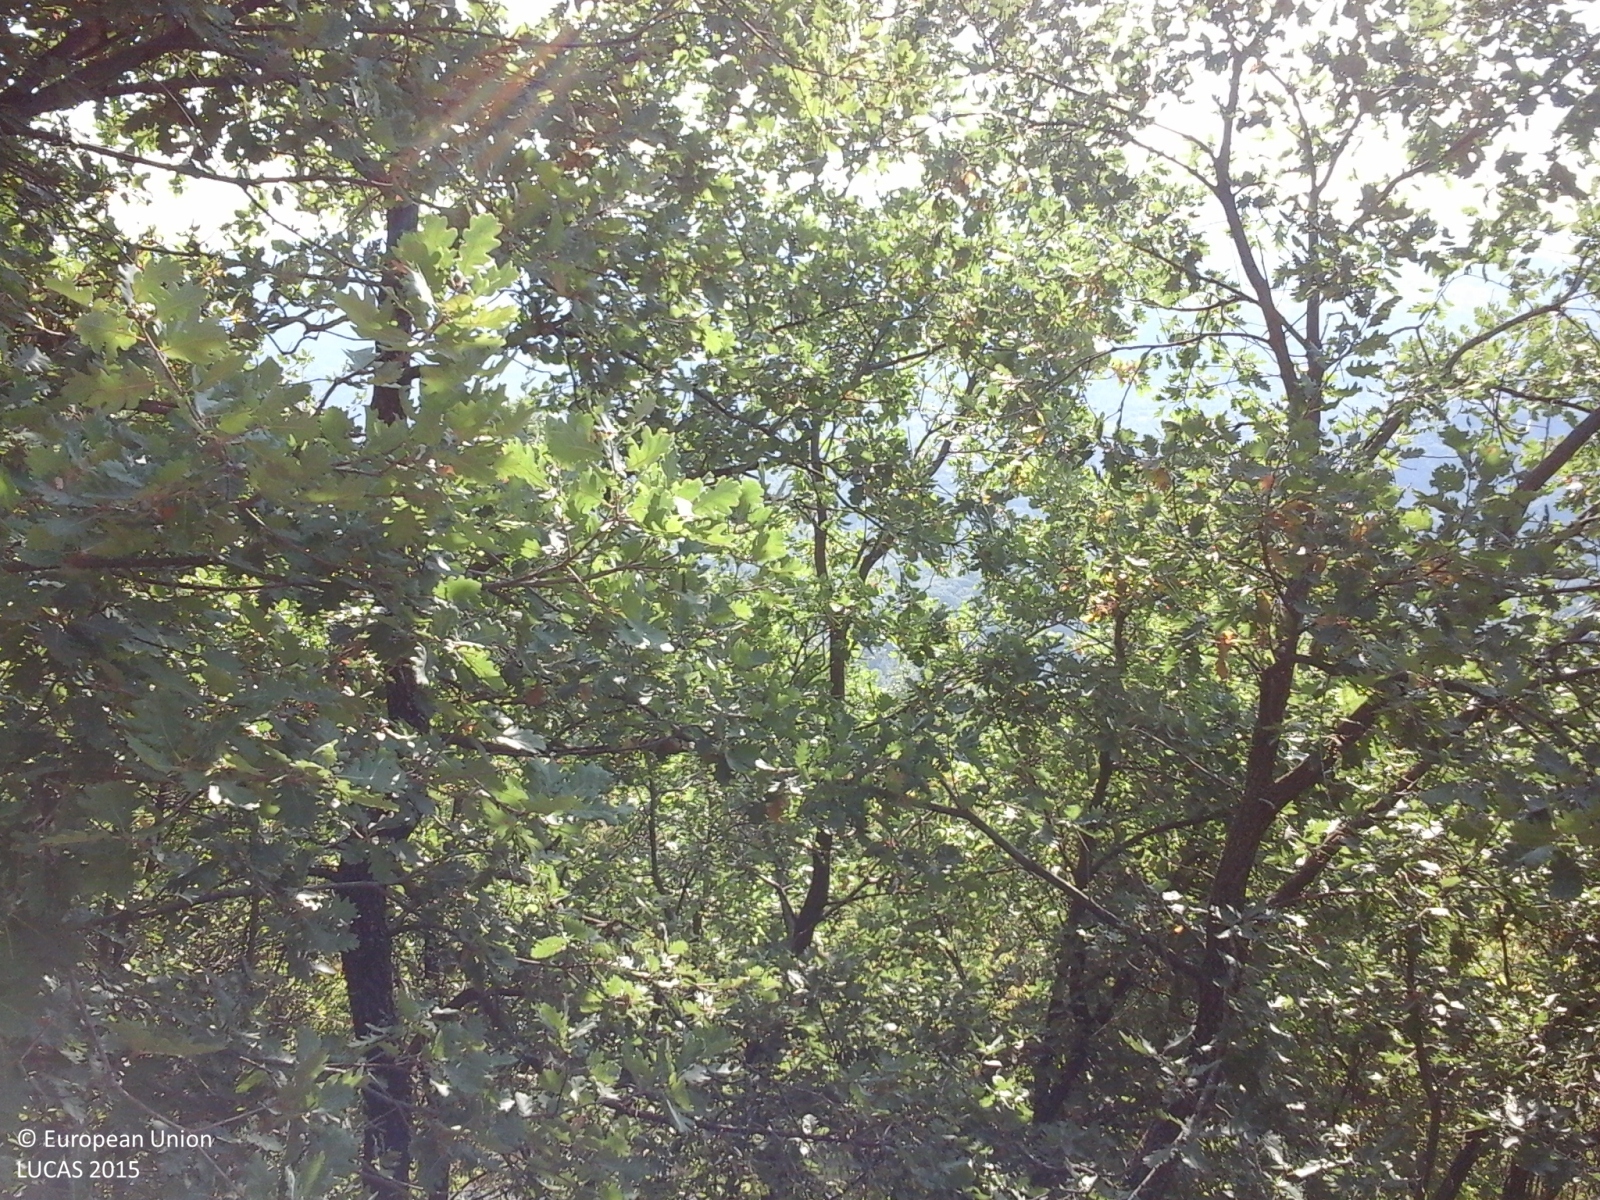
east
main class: Woodland
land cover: Broadleaved woodland
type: thermophilous deciduous forest
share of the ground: > 75 %
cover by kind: broadleaved forest trees 85 %, shrubs 10 %, herbaceous plants 5 %
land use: Semi-natural and natural areas not in use
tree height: > 5 m
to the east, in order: Broadleaved woodland; Grass margins; Paved roads, cycling and walking lanes; Grass margins; Broadleaved woodland; Dry stone walls; Olive groves; Electric lines; Olive groves
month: August
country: IT
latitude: 41.5341
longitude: 14.2396
